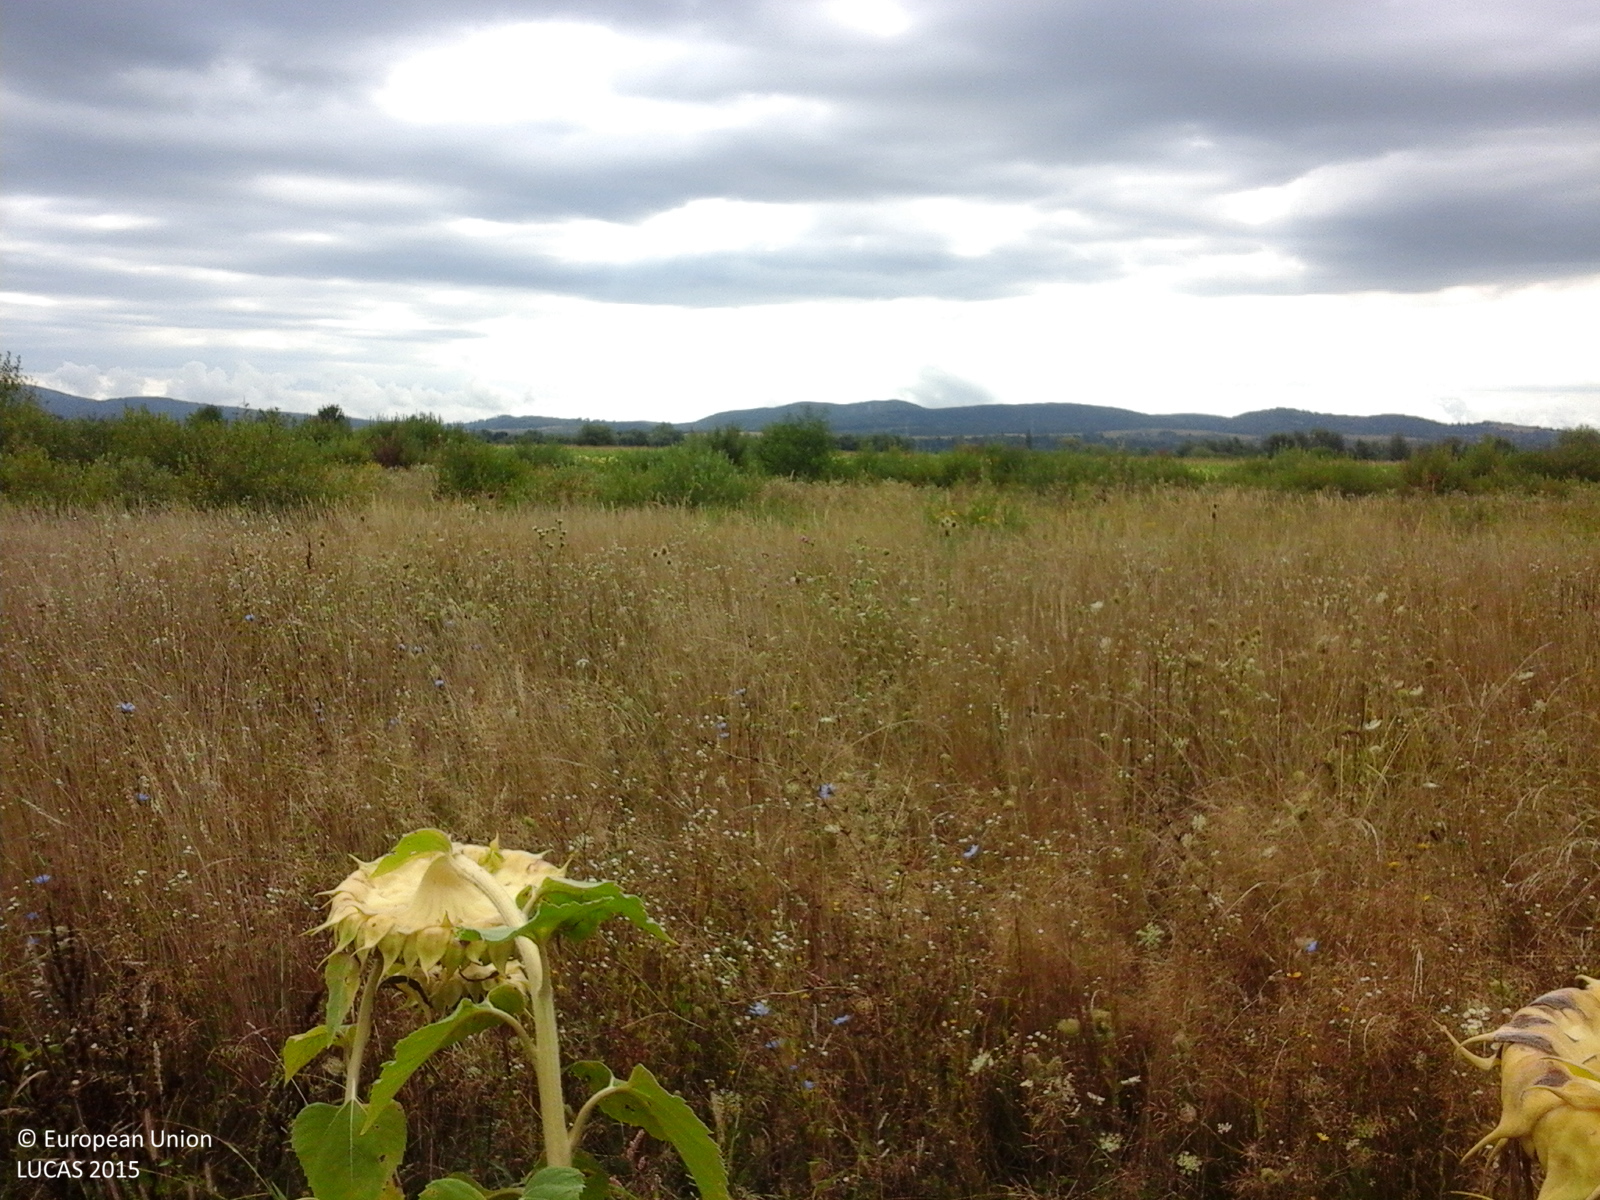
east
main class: Cropland
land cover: Sunflower
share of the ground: > 75 %
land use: Agriculture (excluding fallow land and kitchen gardens)
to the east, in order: Sunflower; Spontaneously vegetated surfaces; Shrubland without tree cover; Sunflower; Shrubland without tree cover; Sunflower; Maize; Spontaneously vegetated surfaces
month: August
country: RO
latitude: 45.4389
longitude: 21.6543
